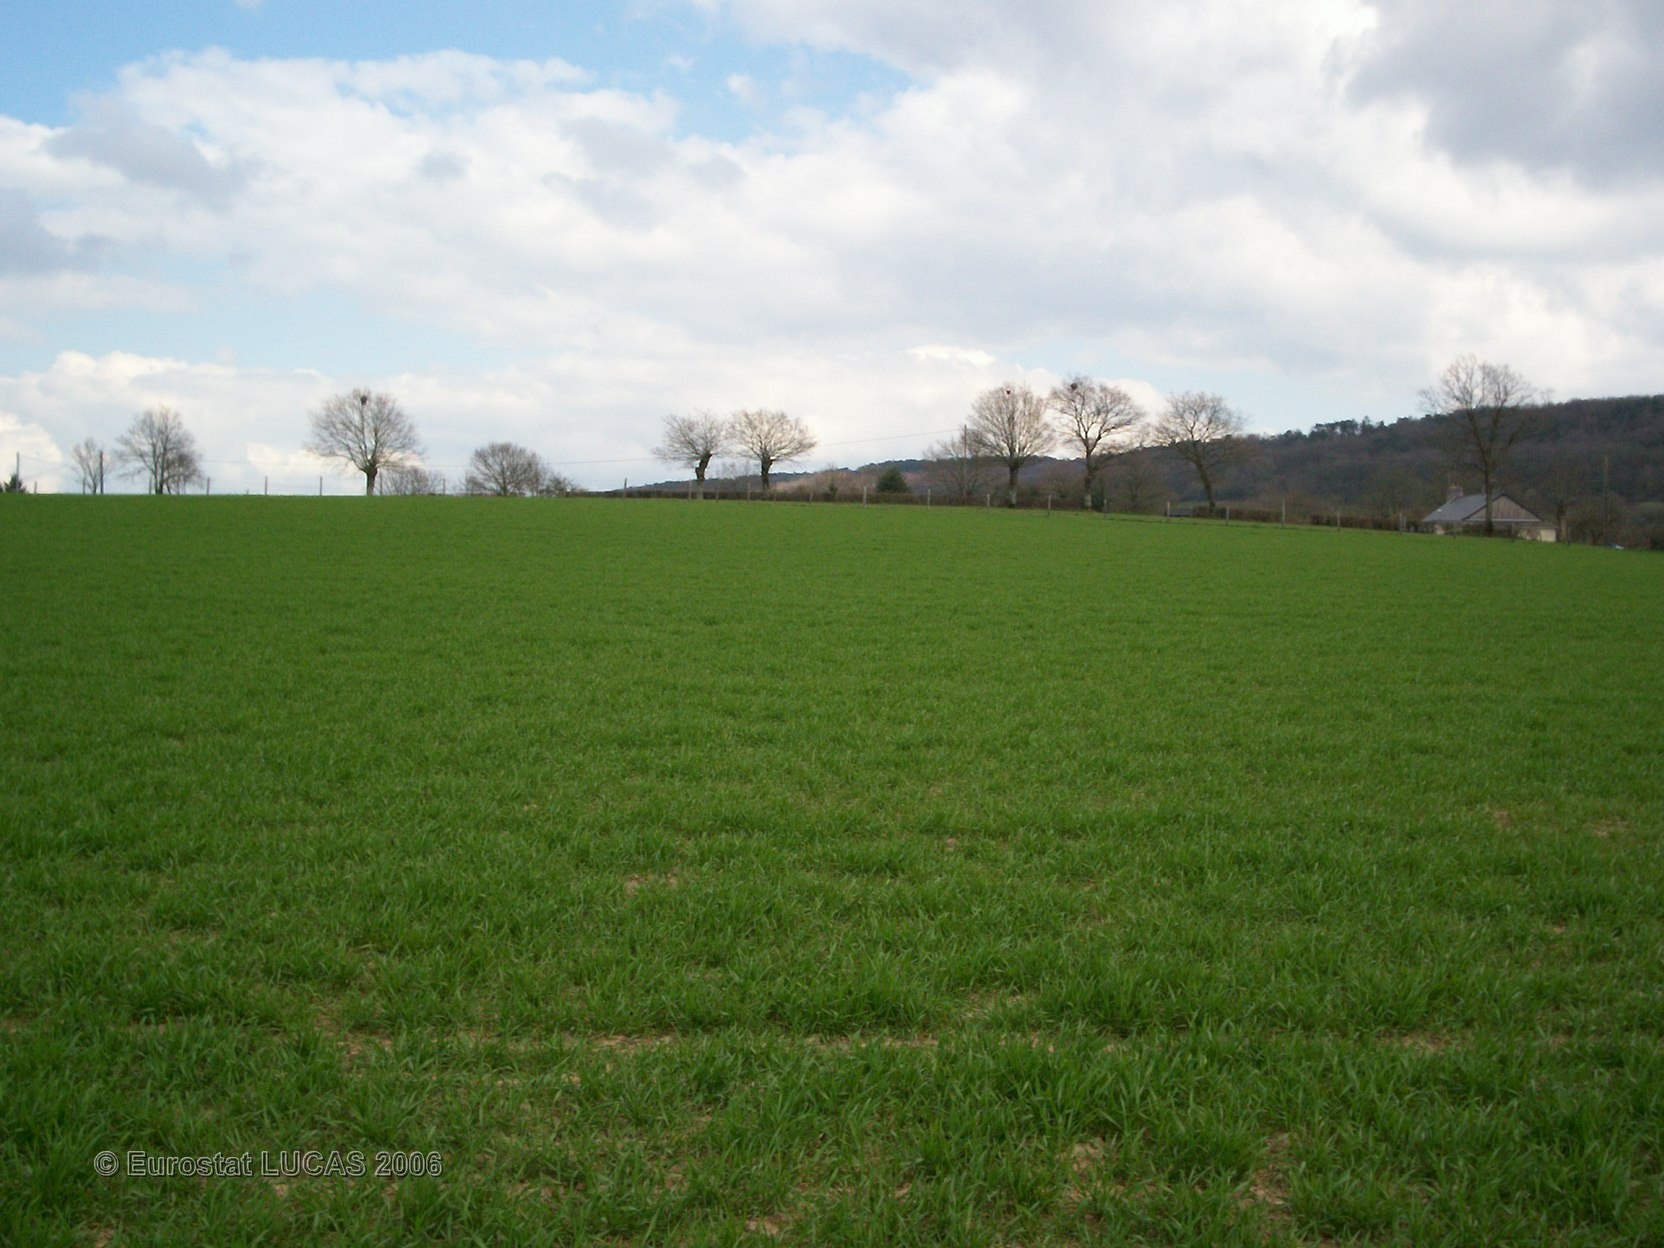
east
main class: Cropland
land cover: Common wheat
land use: Agriculture (excluding fallow land and kitchen gardens)
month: April
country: FR
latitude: 48.3944
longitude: -0.2830
